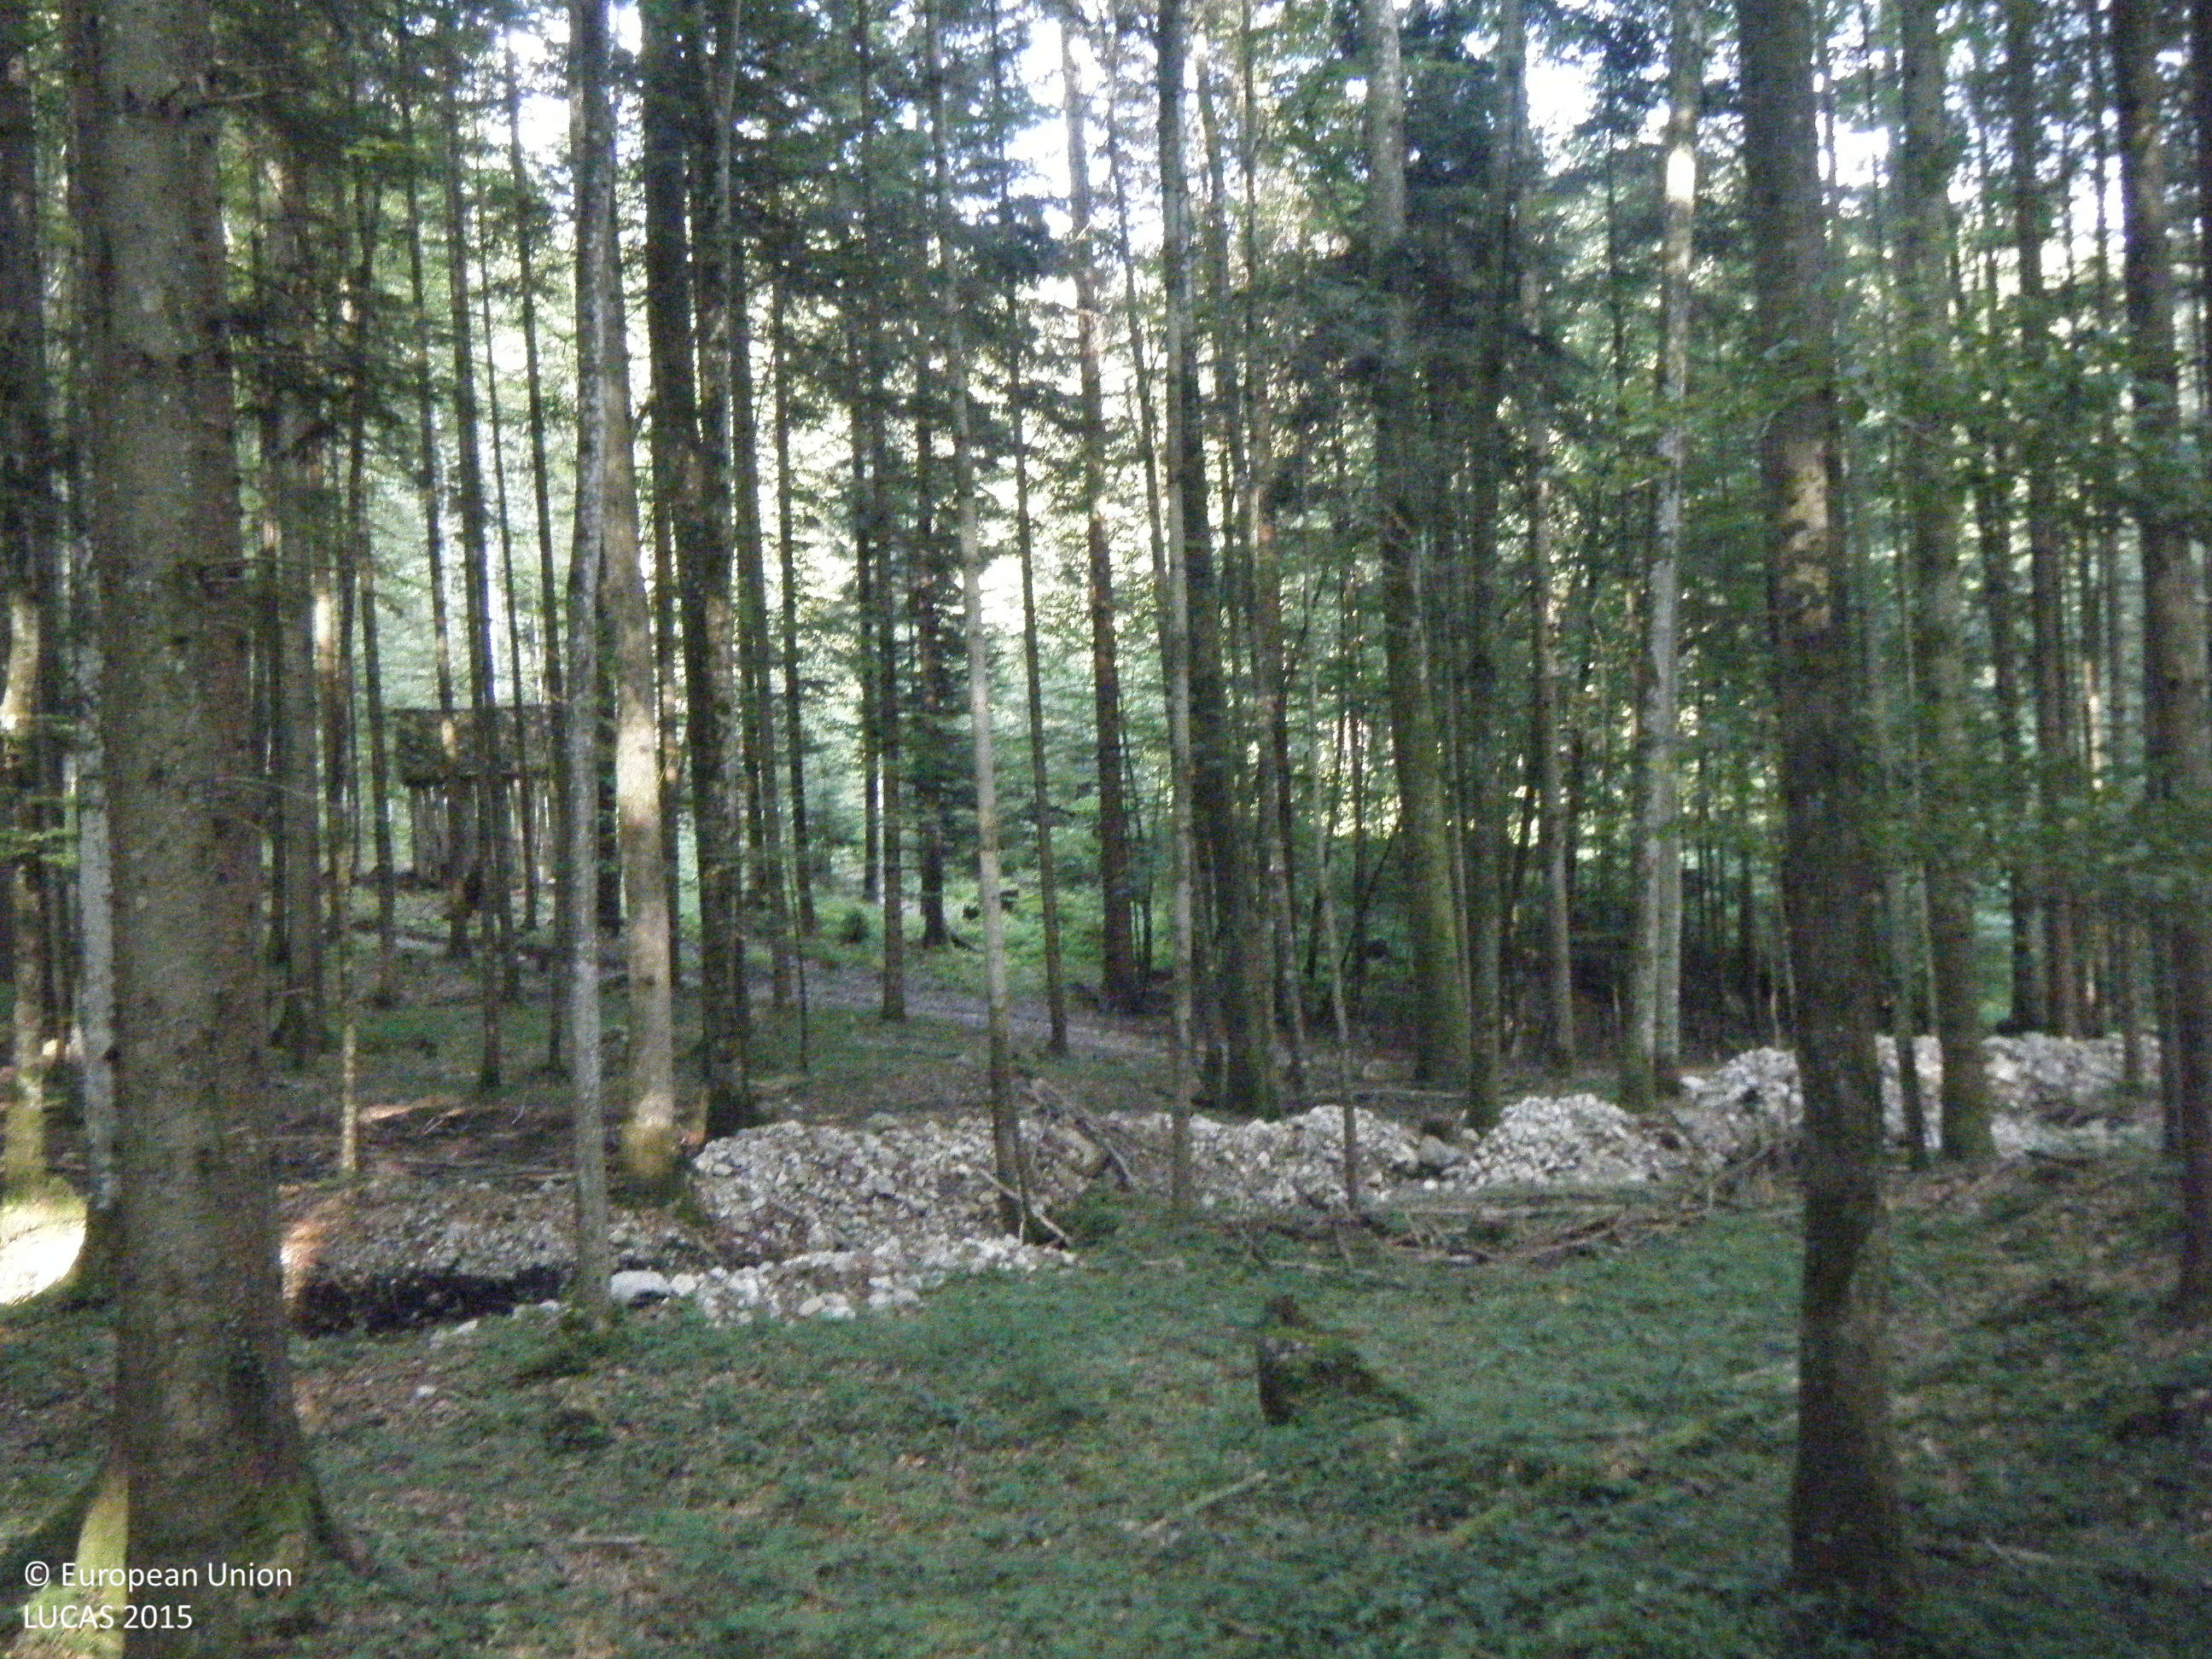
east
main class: Woodland
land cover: Spruce dominated mixed woodland
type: alpine coniferous forest
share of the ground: > 75 %
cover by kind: coniferous forest trees 55 %, broadleaved forest trees 25 %, herbaceous plants 15 %, lichens and mosses 5 %
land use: Forestry
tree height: > 5 m
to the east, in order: Spruce dominated mixed woodland; Rivers and streams; Other structural elements; Spruce dominated mixed woodland; Tracks; Spruce dominated mixed woodland; Grassland with sparse tree/shrub cover; Spruce dominated mixed woodland; Tracks; Spruce dominated mixed woodland; Ditches and canals; Spruce dominated mixed woodland; Groves
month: July
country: AT
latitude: 47.7364
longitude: 13.4791
